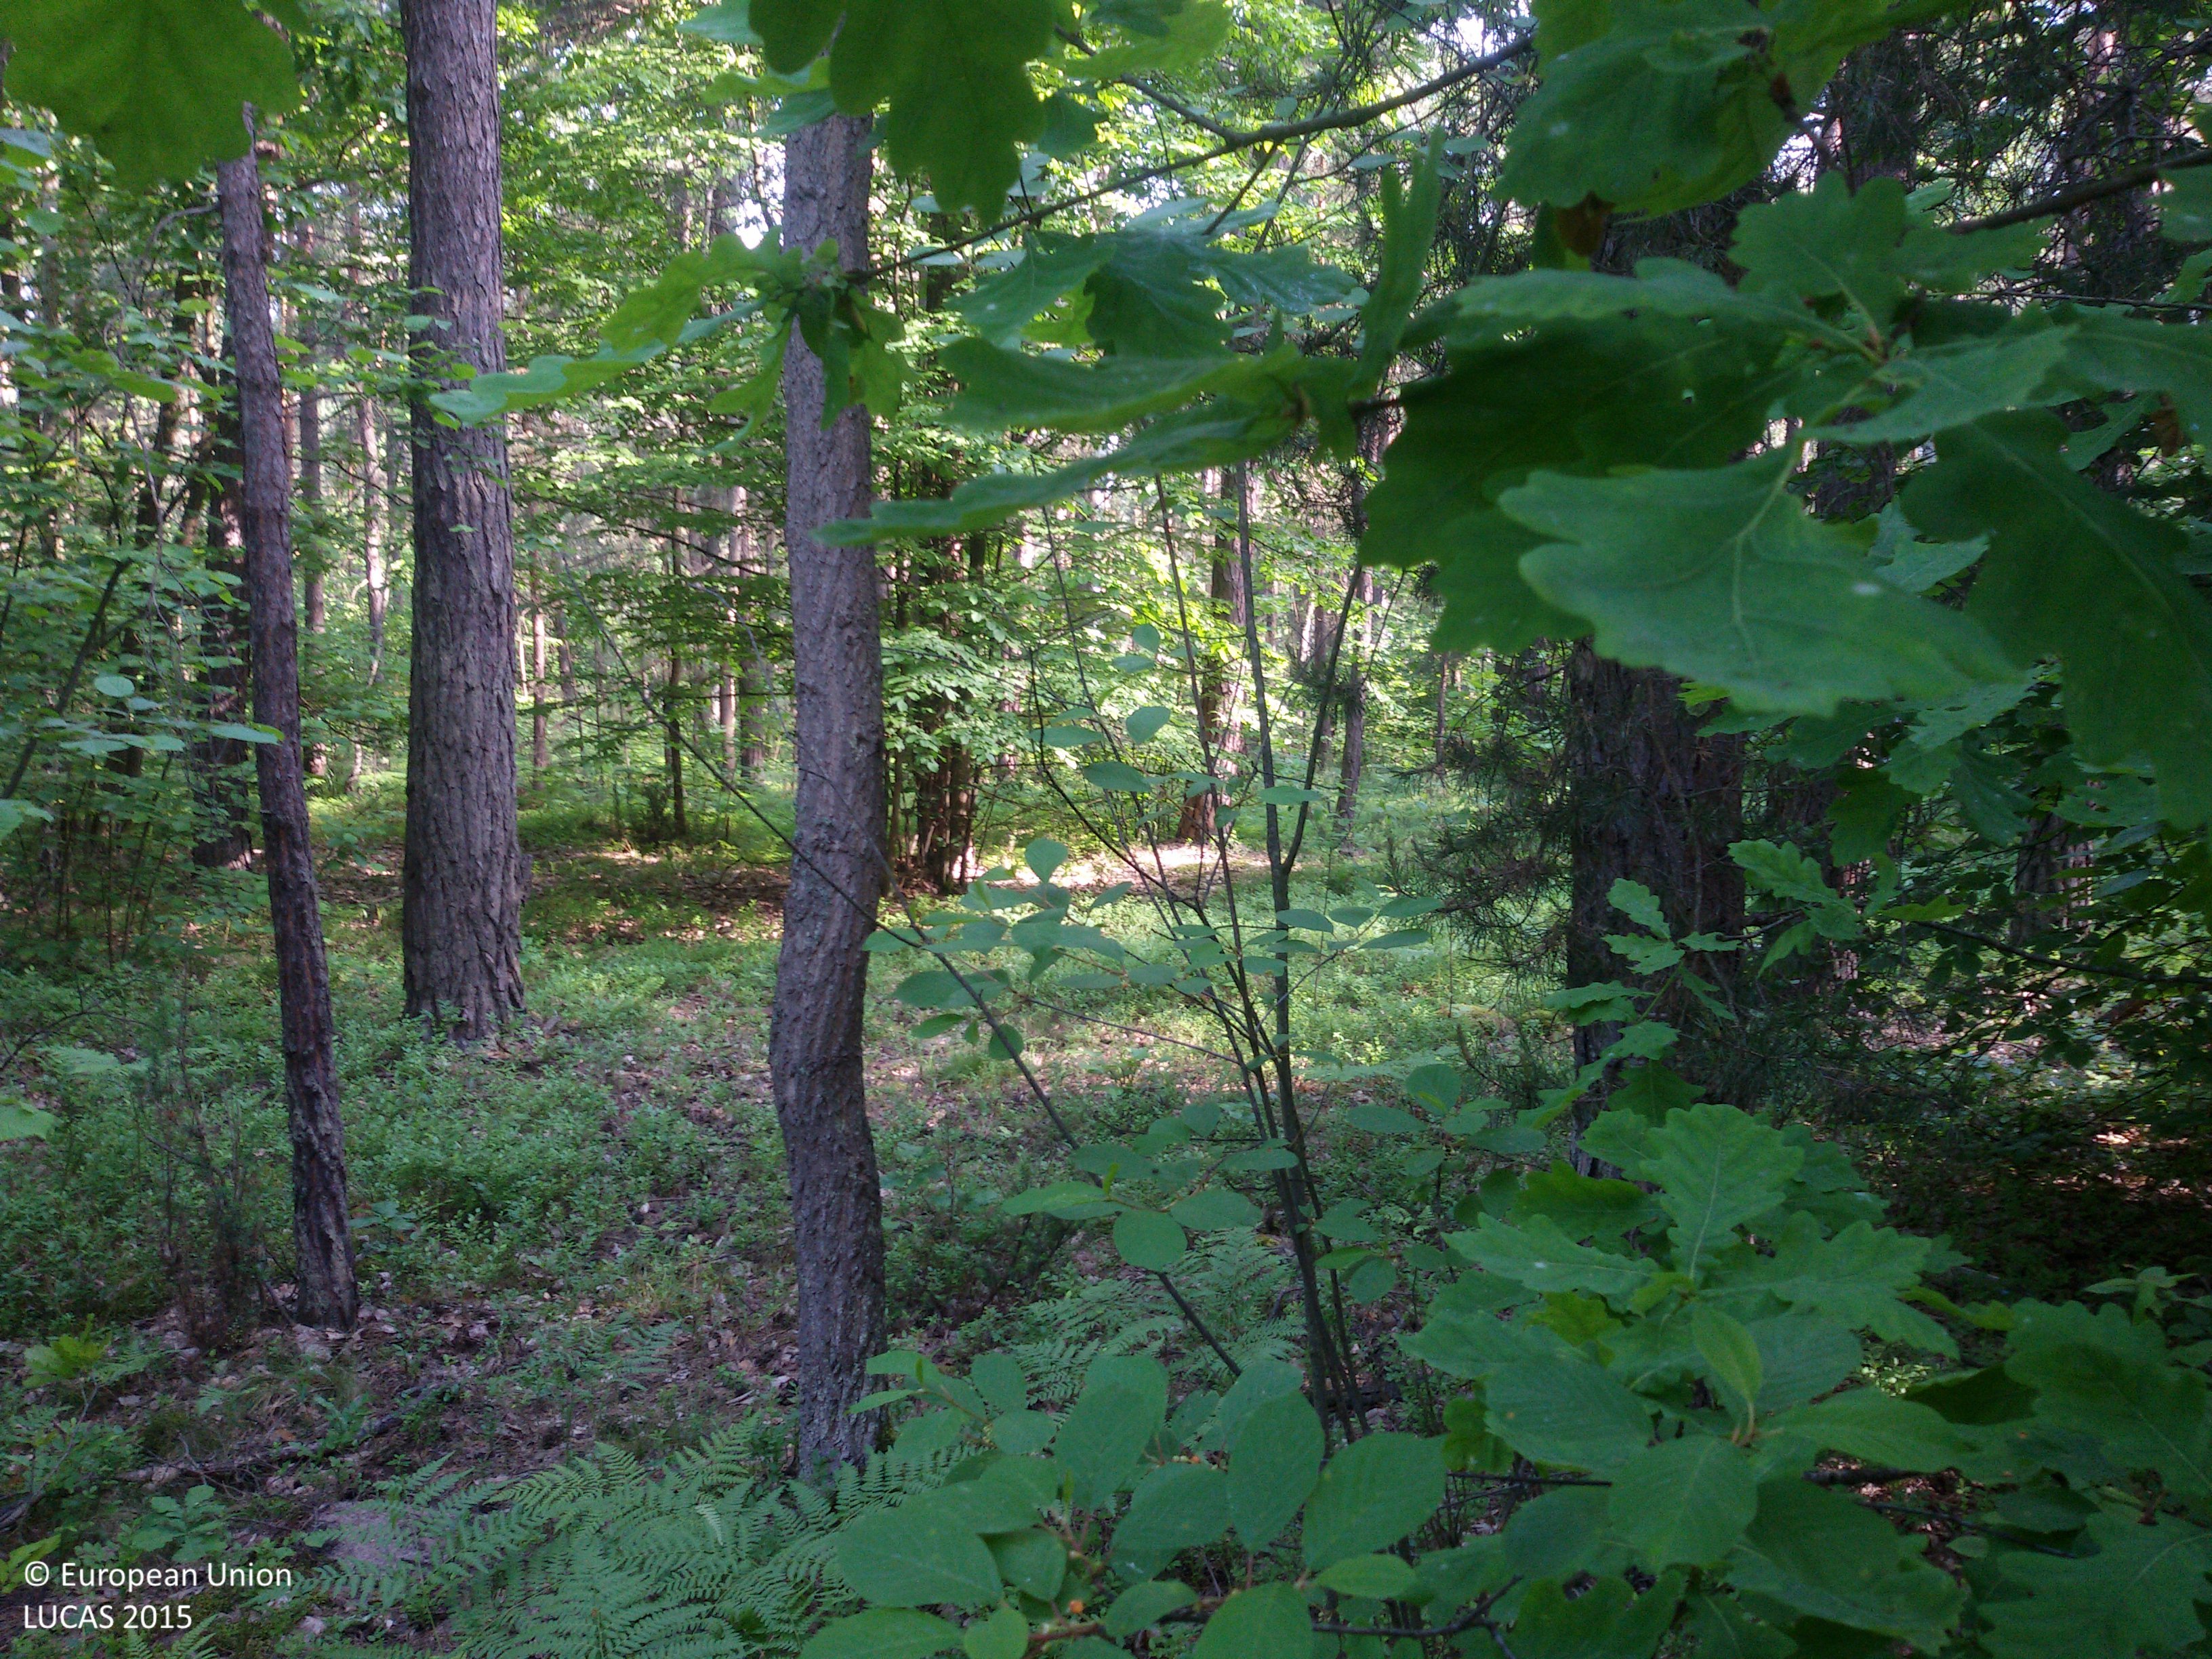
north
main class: Woodland
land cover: Pine dominated coniferous woodland
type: hemiboreal forest and nemoral coniferous forest and mixed broadleaved-coniferous forest
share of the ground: > 75 %
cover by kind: coniferous forest trees 95 %, herbaceous plants 5 %
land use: Forestry
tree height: > 5 m
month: June
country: PL
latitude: 51.4644
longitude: 20.6196
